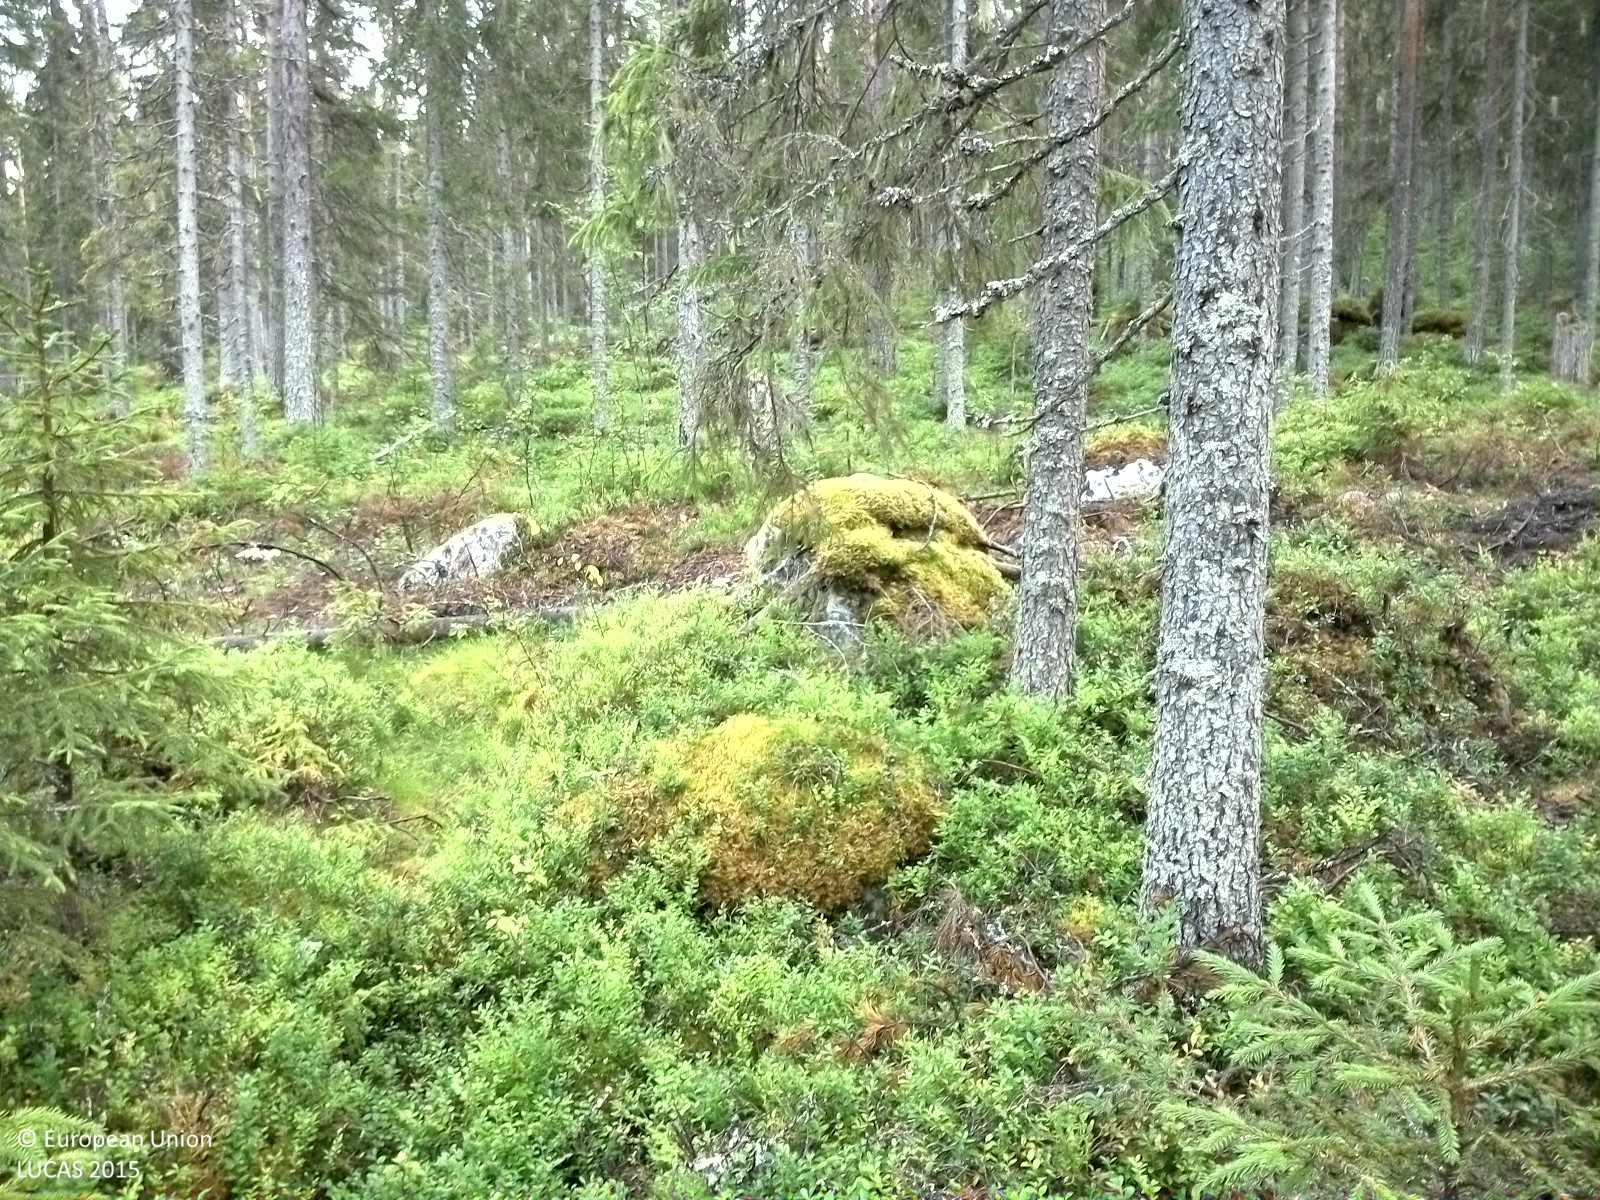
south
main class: Woodland
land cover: Spruce dominated coniferous woodland
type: boreal forest
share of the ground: 25 - 50 %
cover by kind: shrubs 70 %, coniferous forest trees 25 %, lichens and mosses 5 %
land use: Forestry
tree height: > 5 m
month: August
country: SE
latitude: 62.6670
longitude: 16.1668
